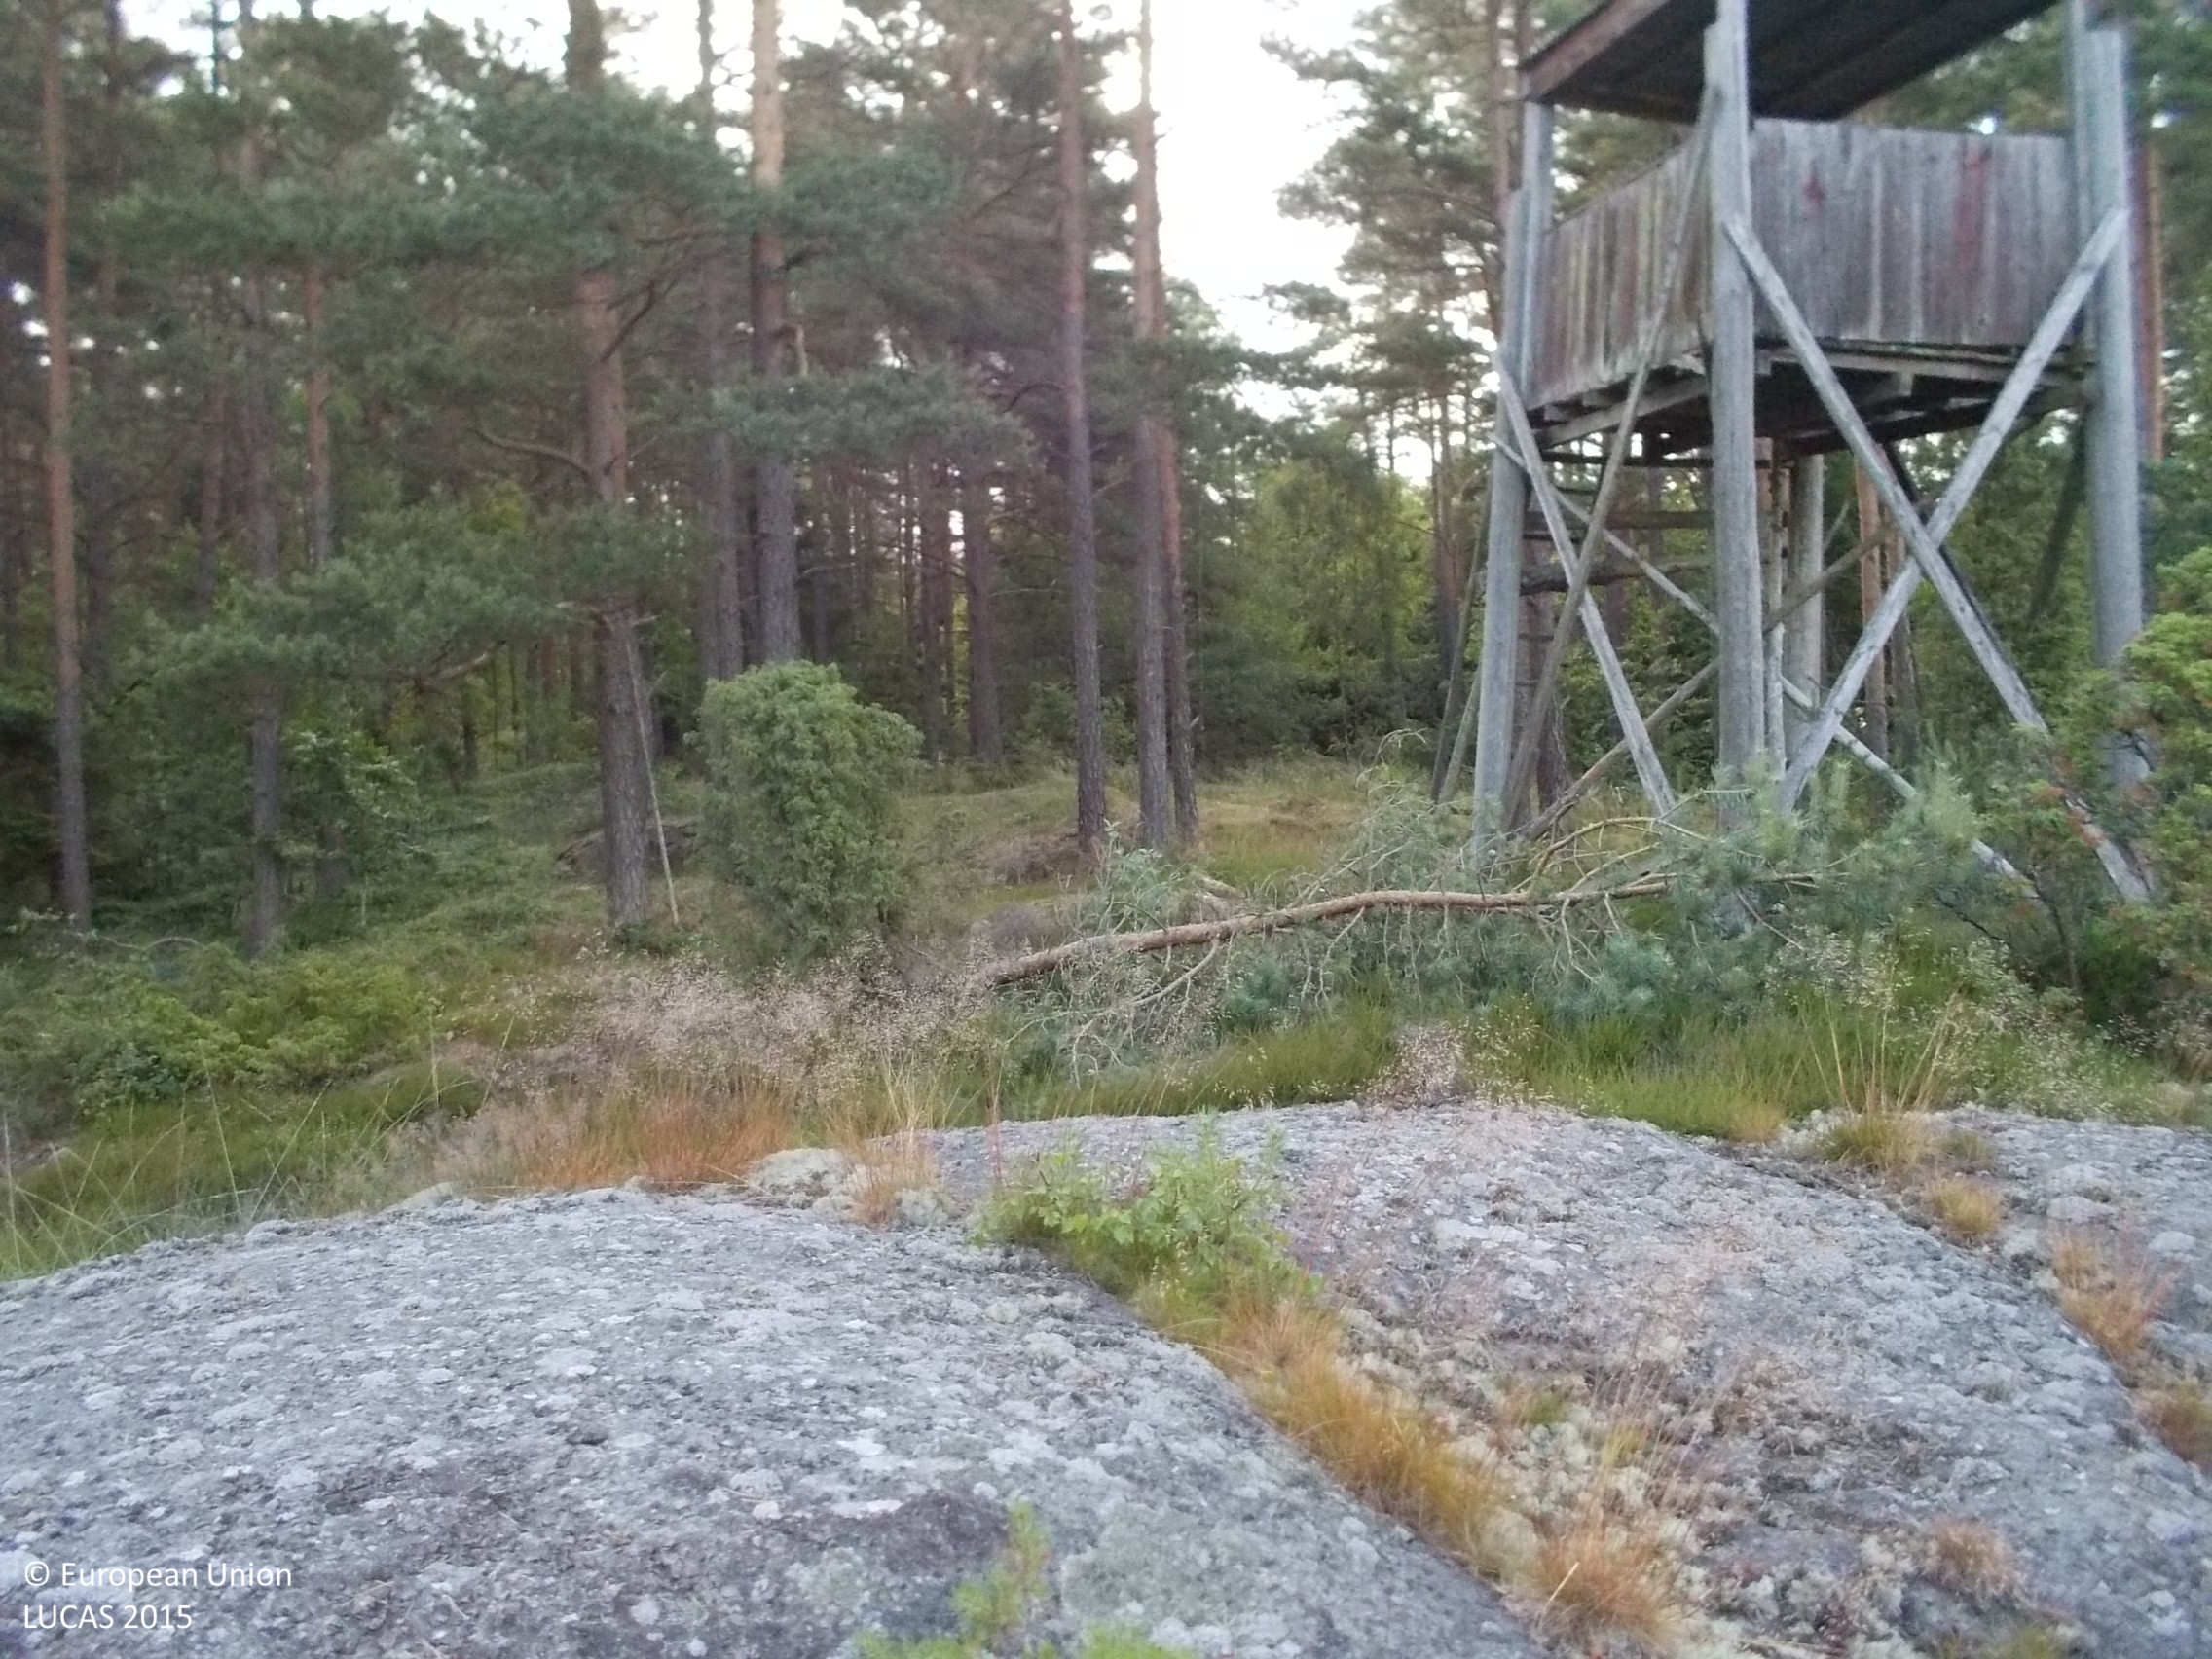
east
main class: Shrubland
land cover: Shrubland with sparse tree cover
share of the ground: > 75 %
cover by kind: shrubs 70 %, herbaceous plants 10 %, lichens and mosses 10 %, broadleaved forest trees 5 %, consolidated bare surface 5 %
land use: Electricity, gas and thermal power distribution
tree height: < 5 m
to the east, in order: Shrubland with sparse tree cover; Rocks and stones; Pine dominated coniferous woodland; Dry stone walls; Spruce dominated coniferous woodland; Pine dominated mixed woodland
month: July
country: SE
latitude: 57.1930
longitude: 12.2639
